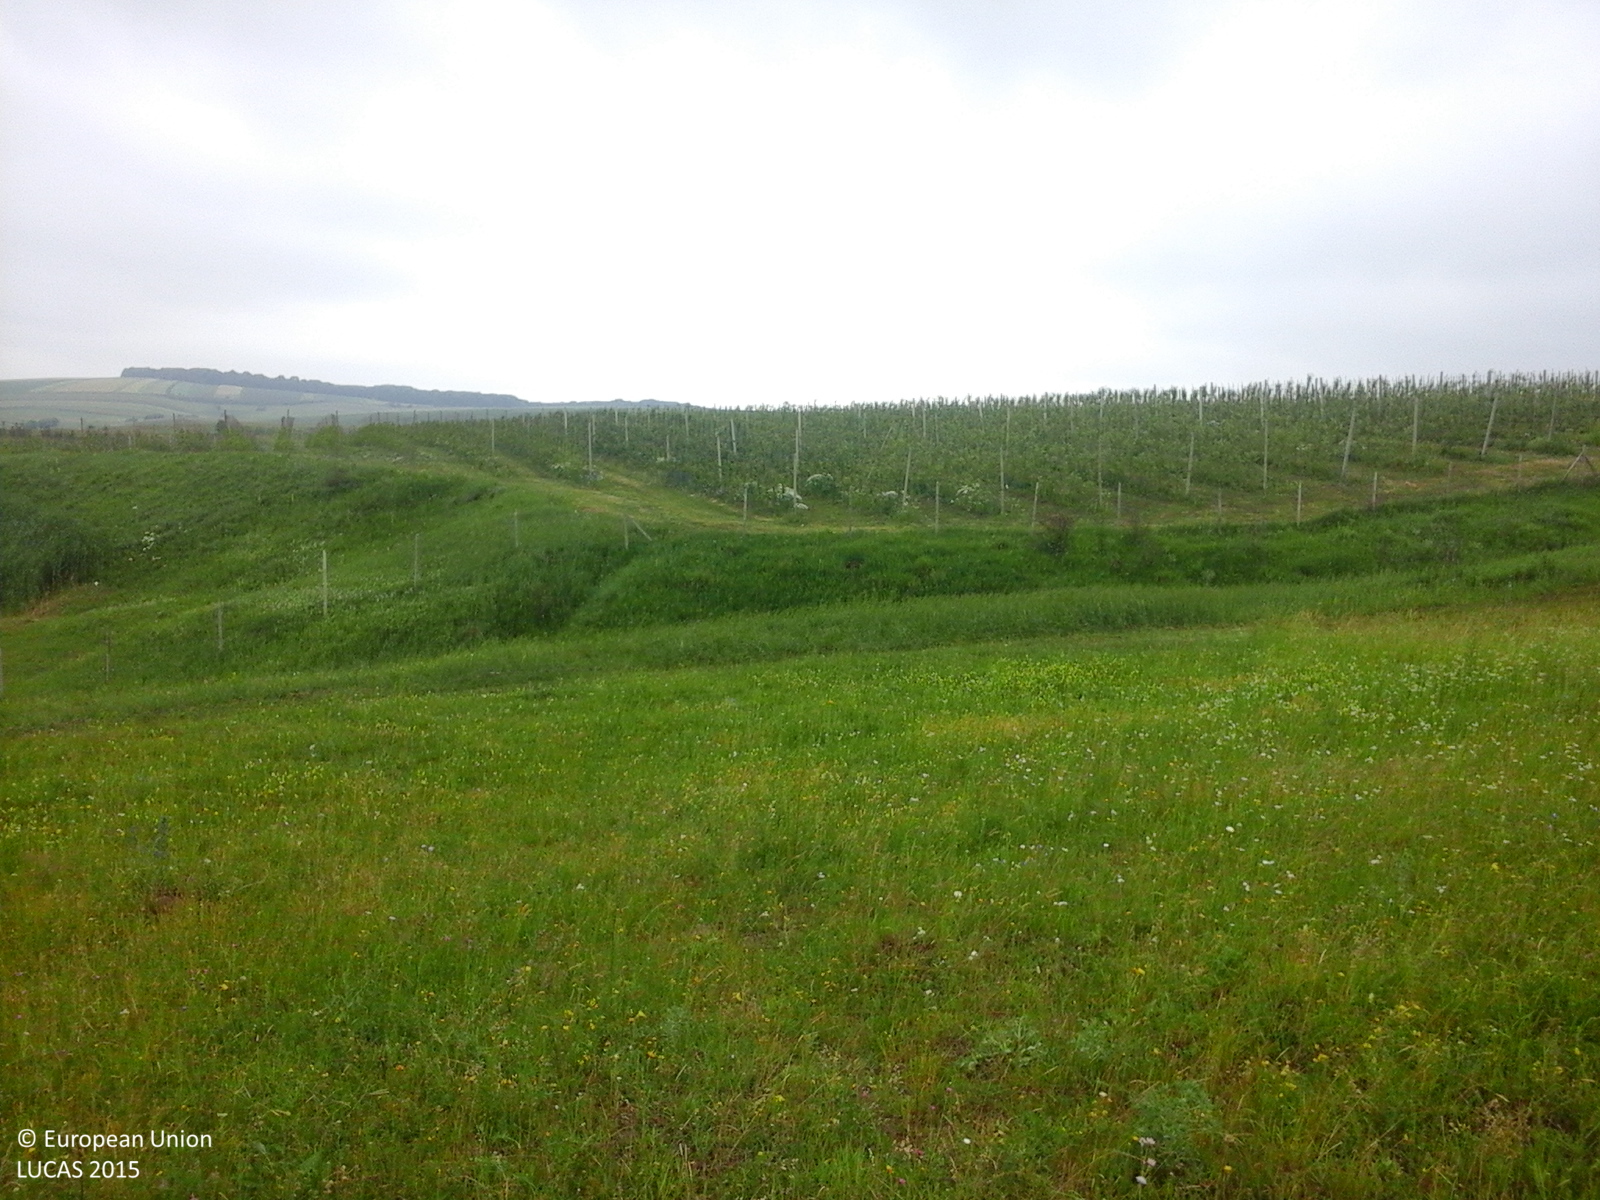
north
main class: Grassland
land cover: Grassland without tree/shrub cover
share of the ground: > 75 %
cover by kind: herbaceous plants 100 %
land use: Agriculture (excluding fallow land and kitchen gardens)
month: June
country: RO
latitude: 47.3931
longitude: 26.3669
